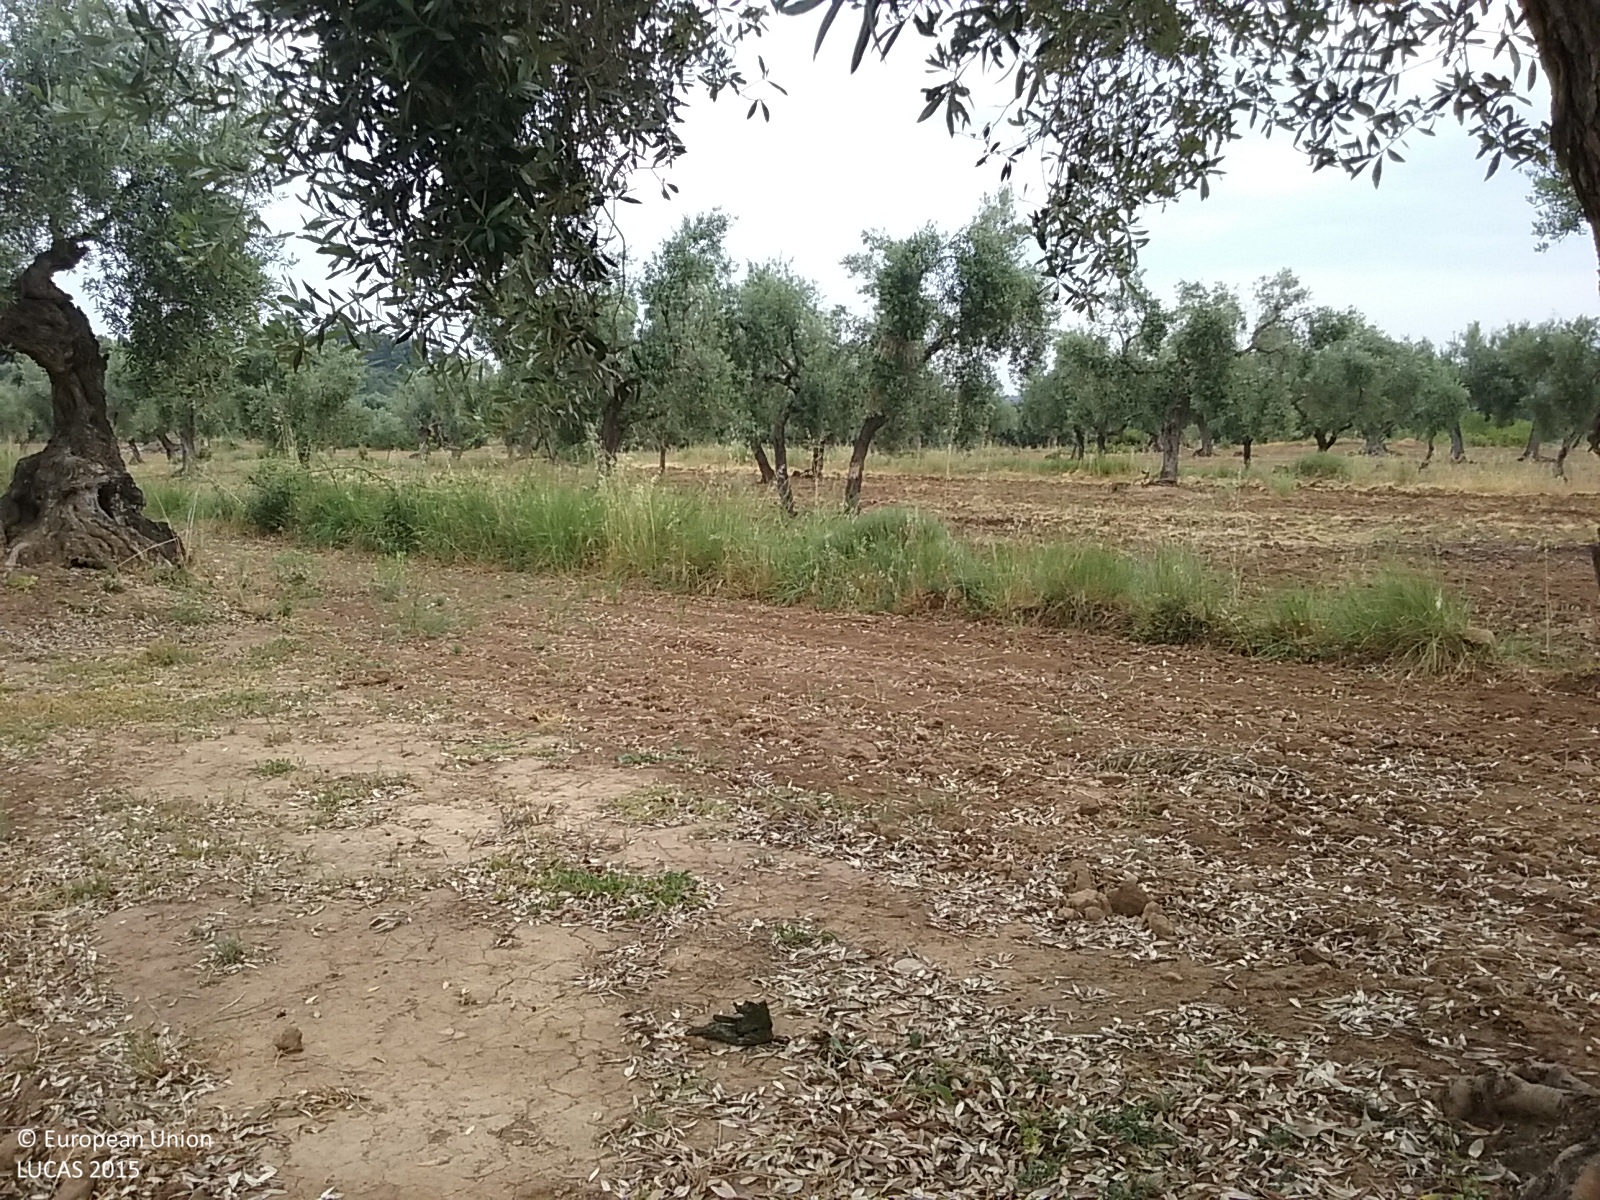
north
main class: Cropland
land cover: Olive groves
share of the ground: 25 - 50 %
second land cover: Spontaneously vegetated surfaces
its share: < 10 %
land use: Agriculture (excluding fallow land and kitchen gardens)
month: June
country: ES
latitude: 40.9221
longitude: 0.1950
